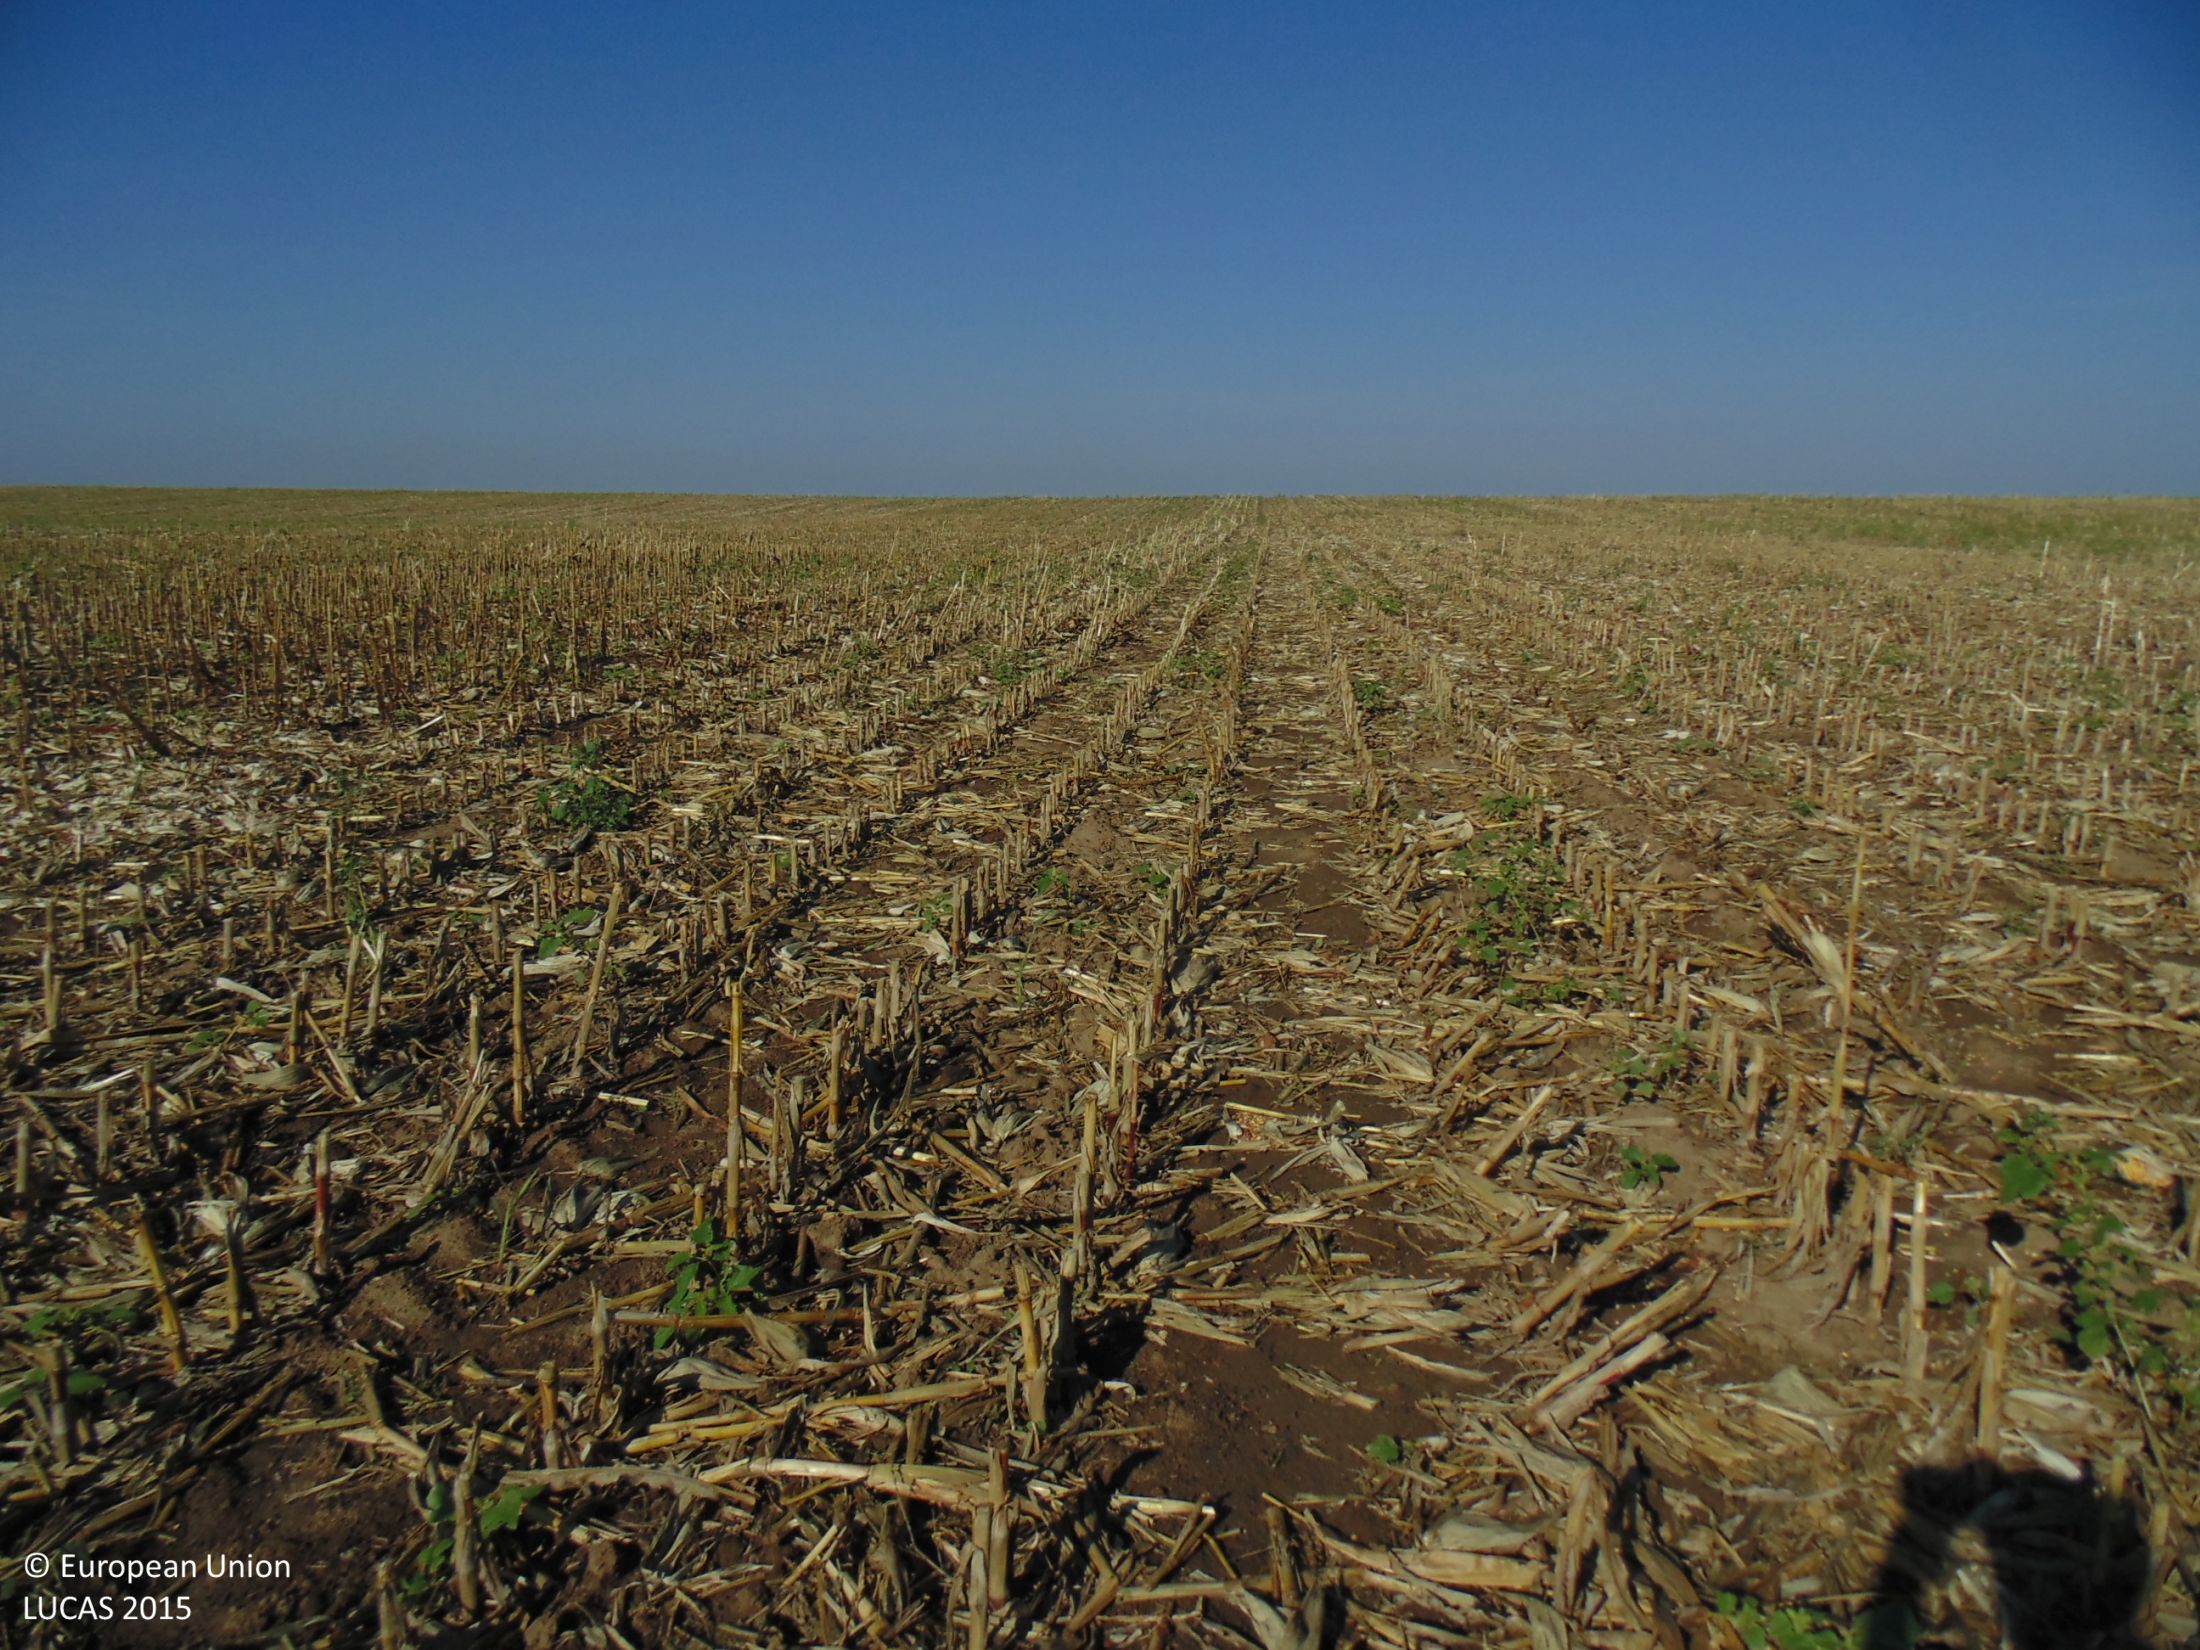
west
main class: Cropland
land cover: Maize
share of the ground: 10 - 25 %
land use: Agriculture (excluding fallow land and kitchen gardens)
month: September
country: BG
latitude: 44.1080
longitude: 27.0291
